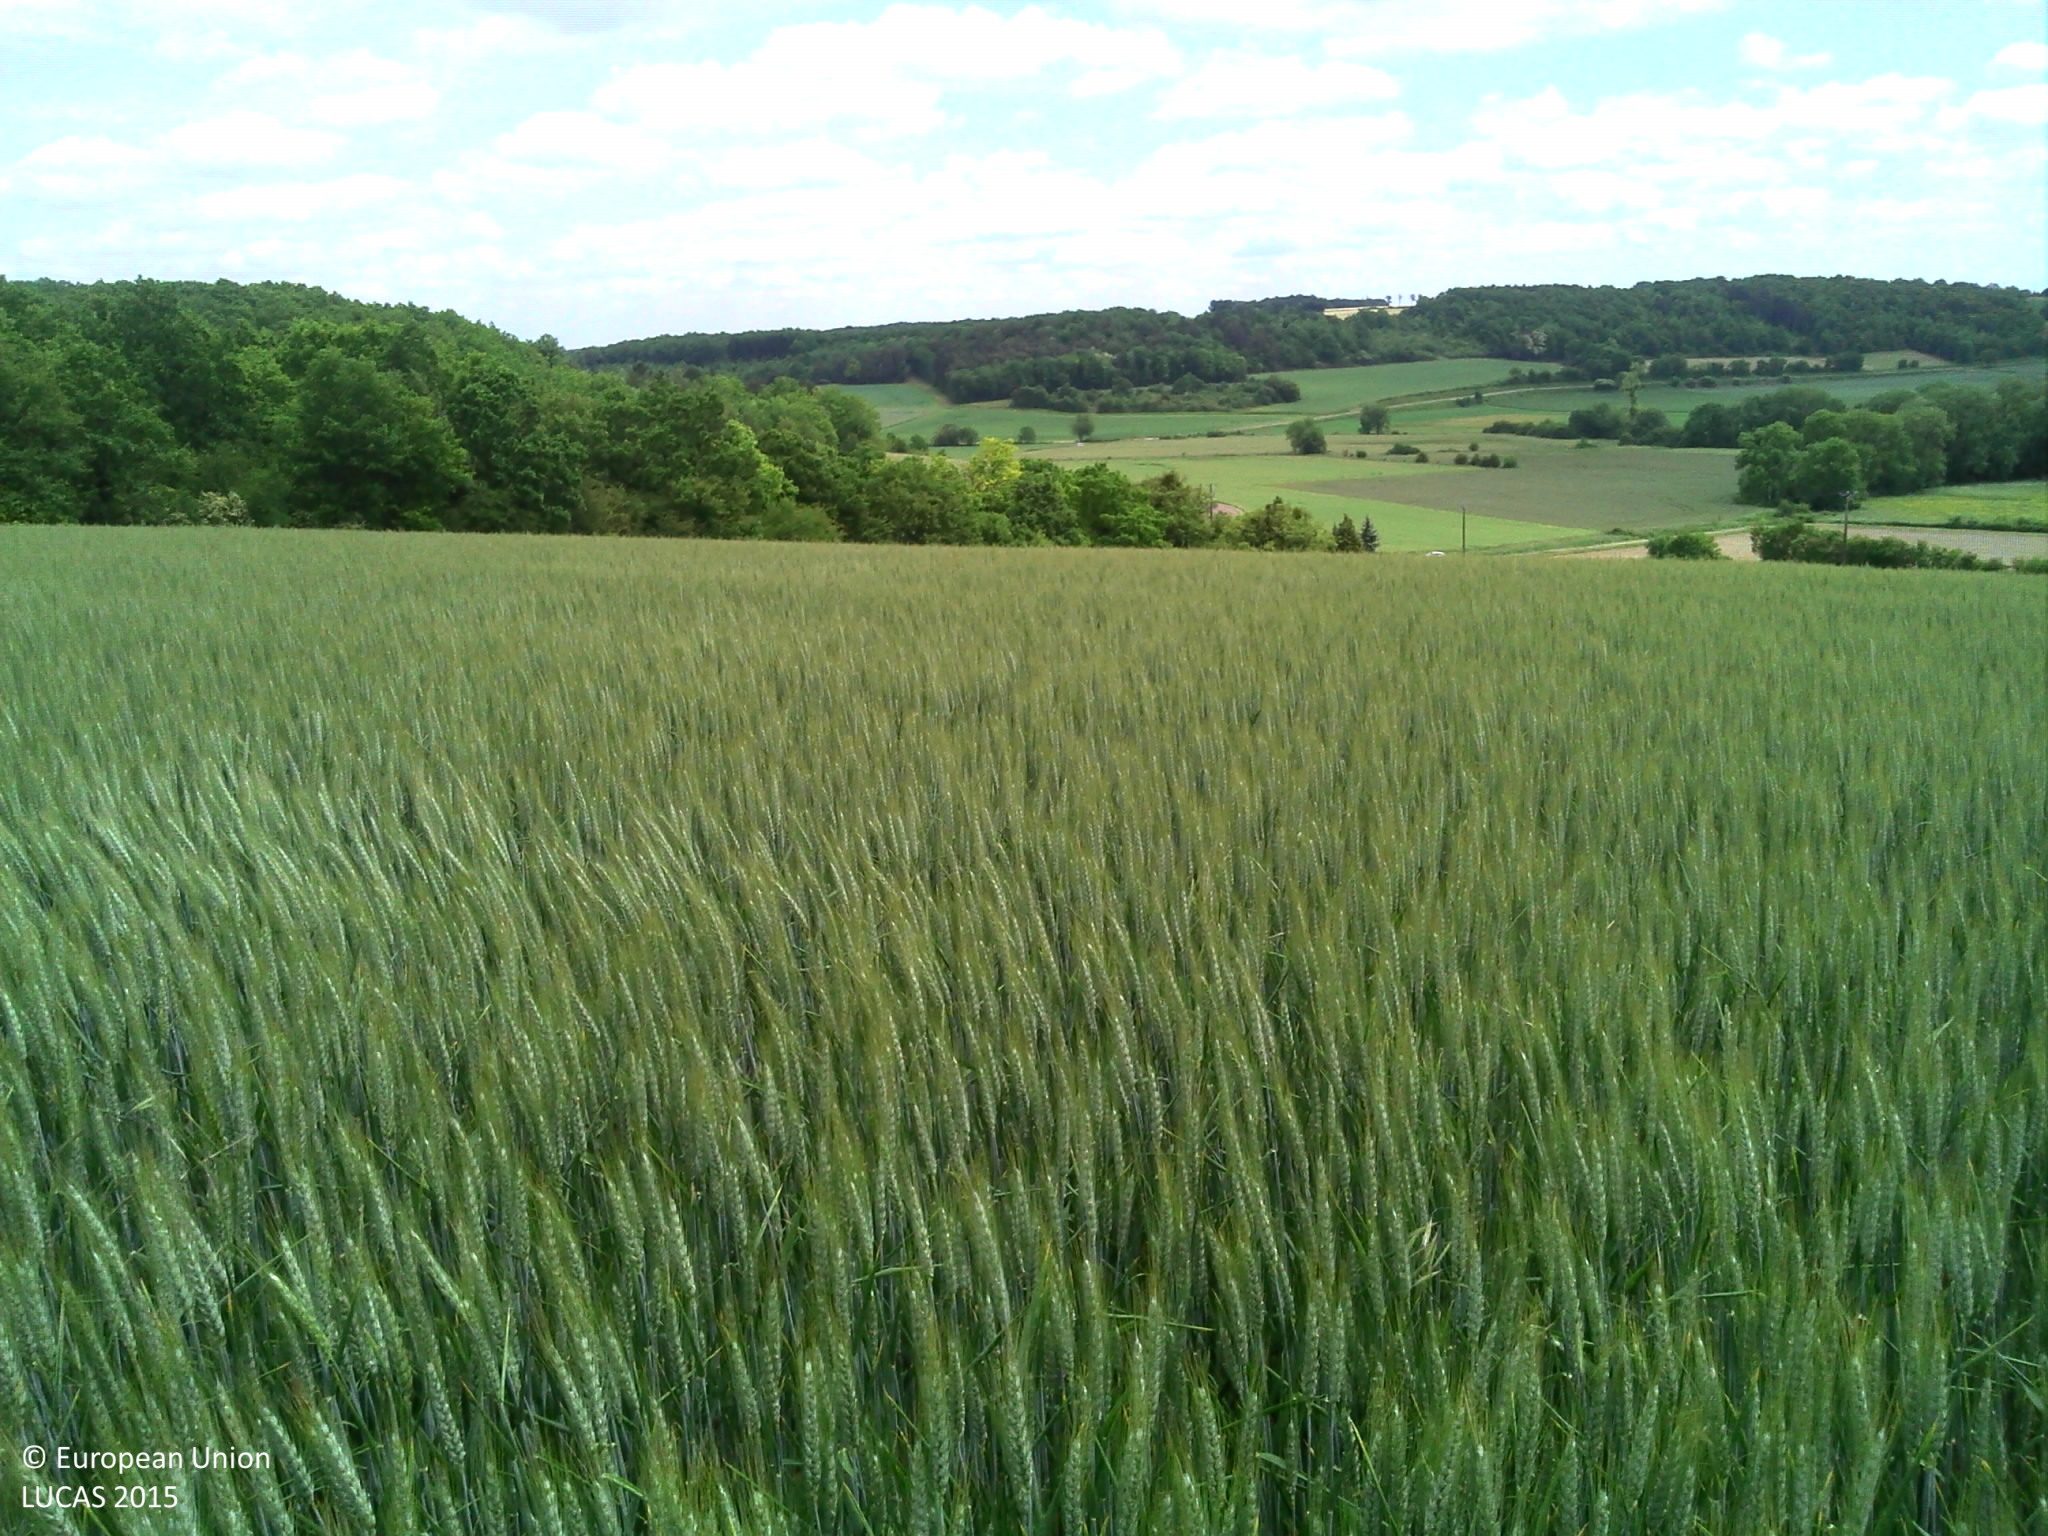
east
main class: Cropland
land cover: Common wheat
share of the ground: > 75 %
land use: Agriculture (excluding fallow land and kitchen gardens)
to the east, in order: Common wheat; Broadleaved woodland; Grassland without tree/shrub cover; Fences; Rivers and streams; Single bushes/trees; Grassland without tree/shrub cover
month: May
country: FR
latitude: 47.7494
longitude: 3.9281
